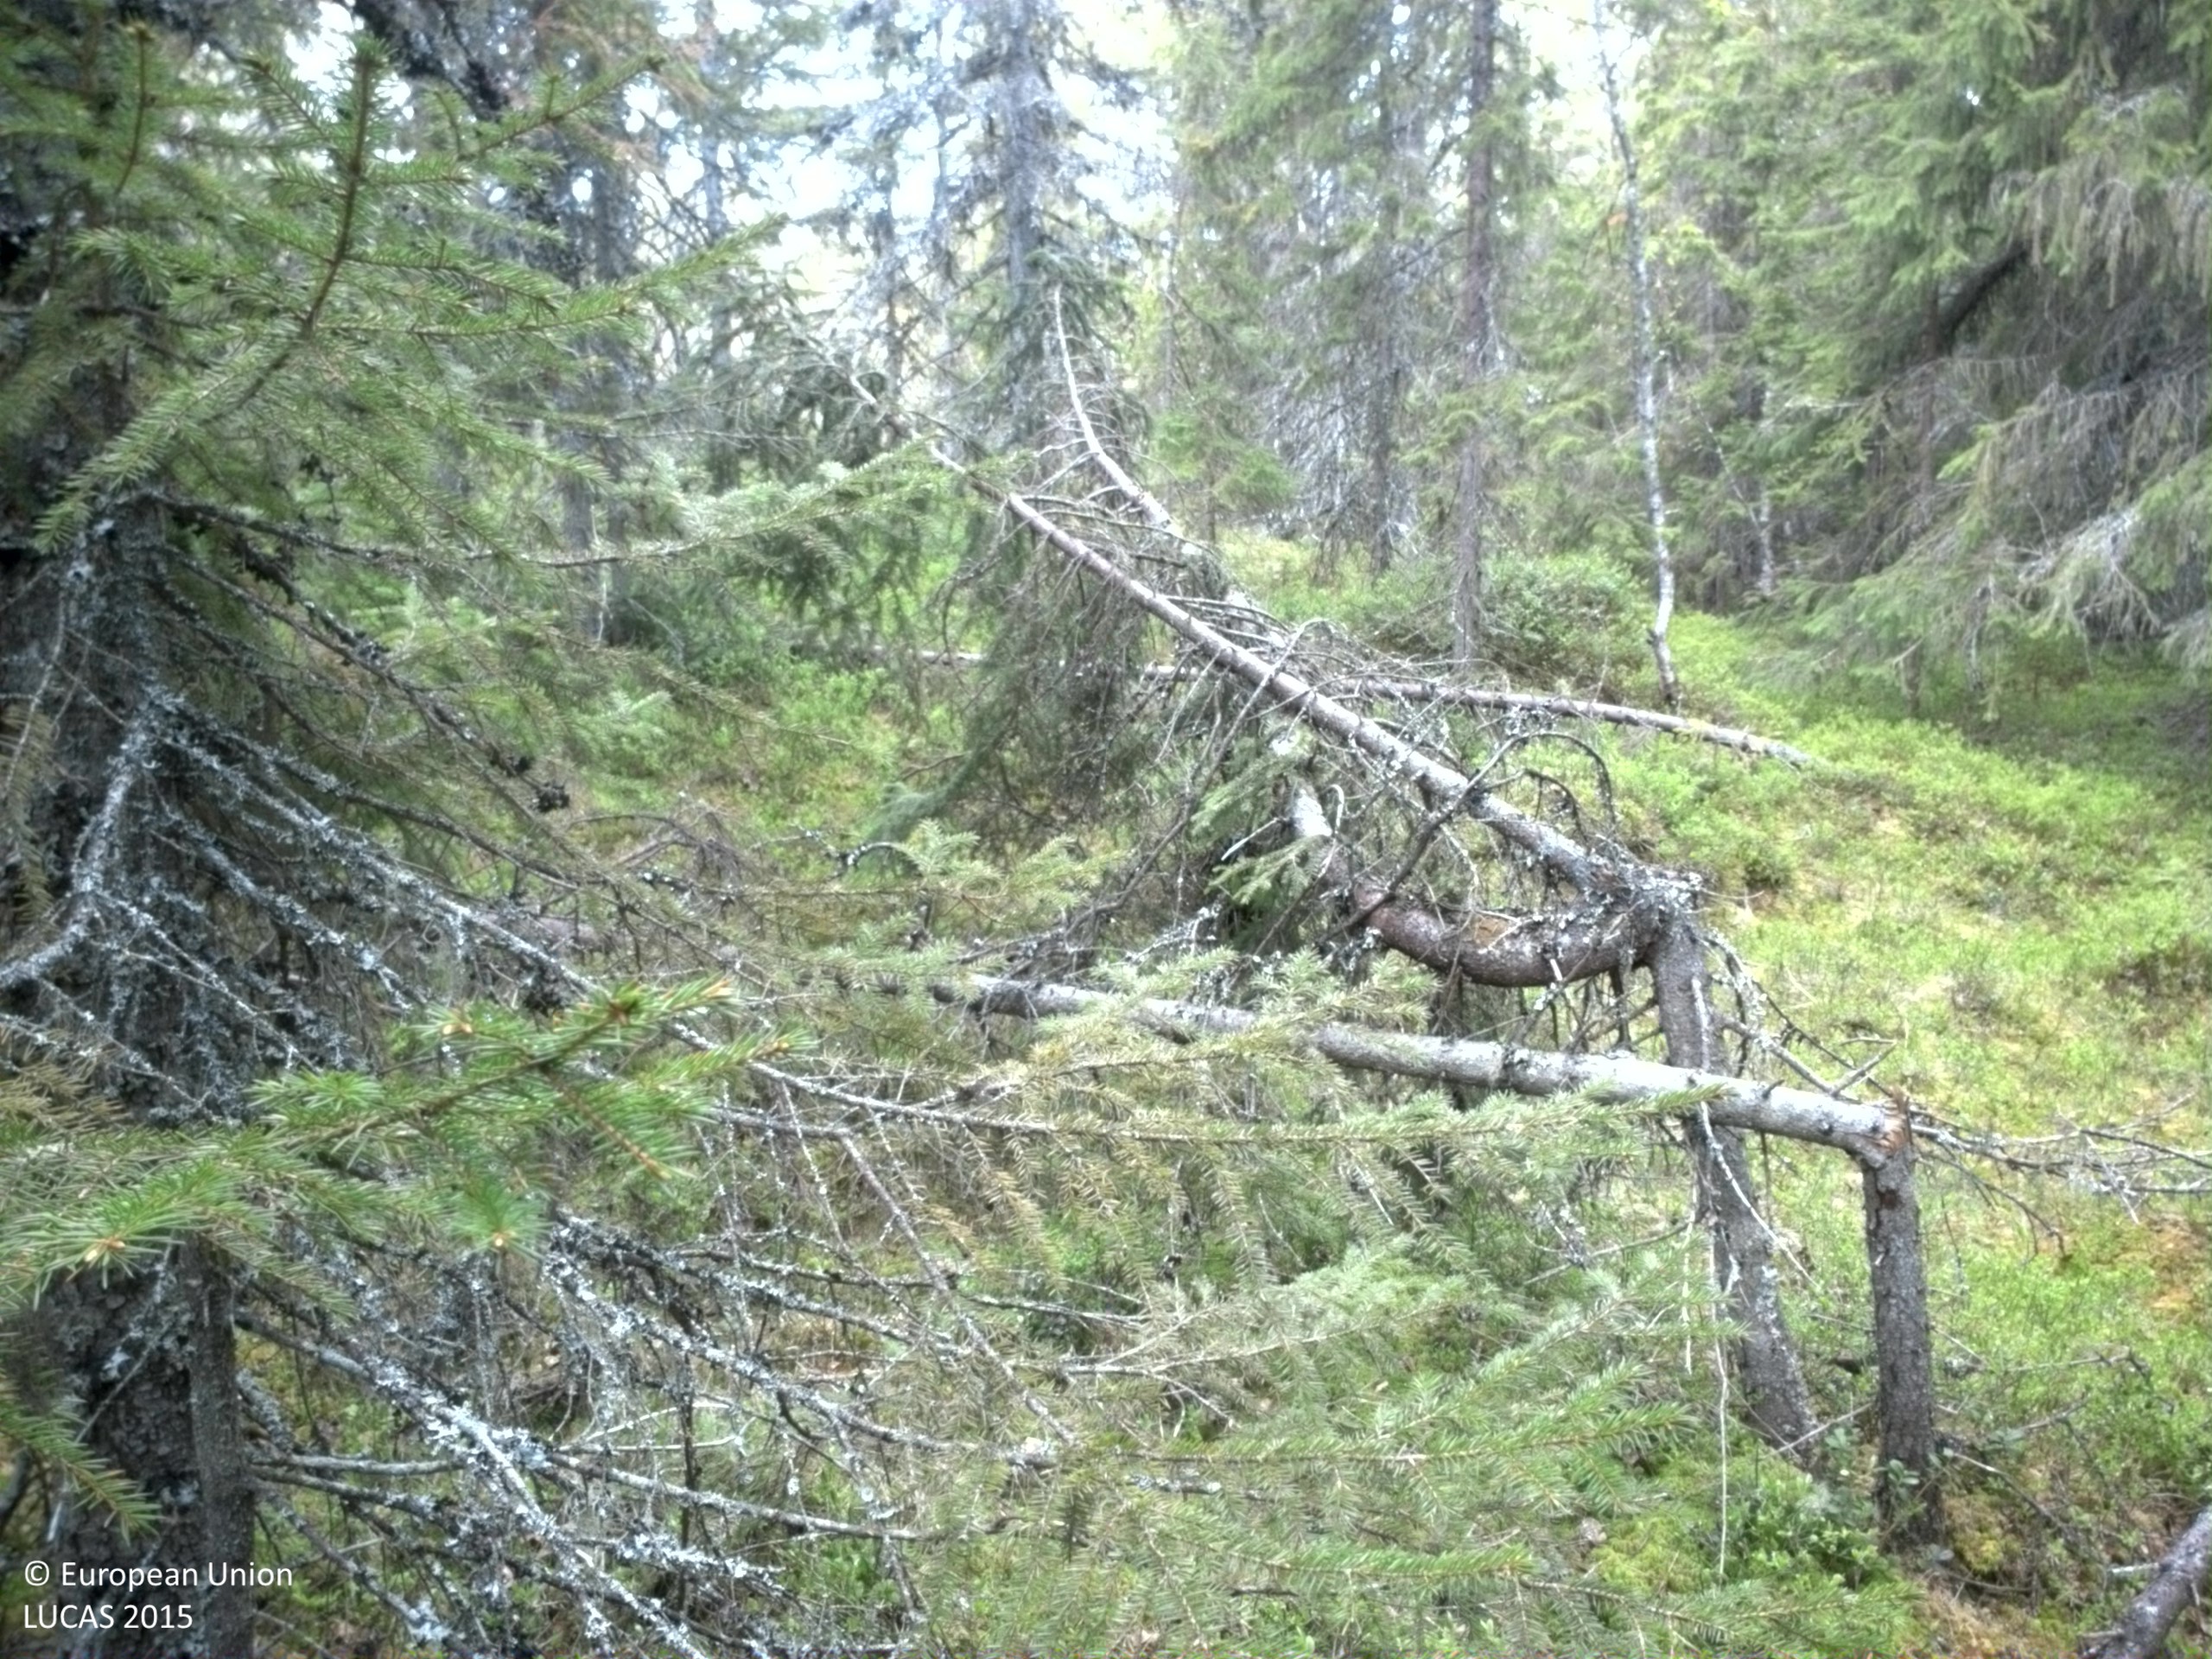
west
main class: Woodland
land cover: Spruce dominated coniferous woodland
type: boreal forest
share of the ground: 50 - 75 %
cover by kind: coniferous forest trees 60 %, shrubs 30 %, lichens and mosses 10 %
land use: Forestry
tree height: > 5 m
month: June
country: SE
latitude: 62.9234
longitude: 17.3225
